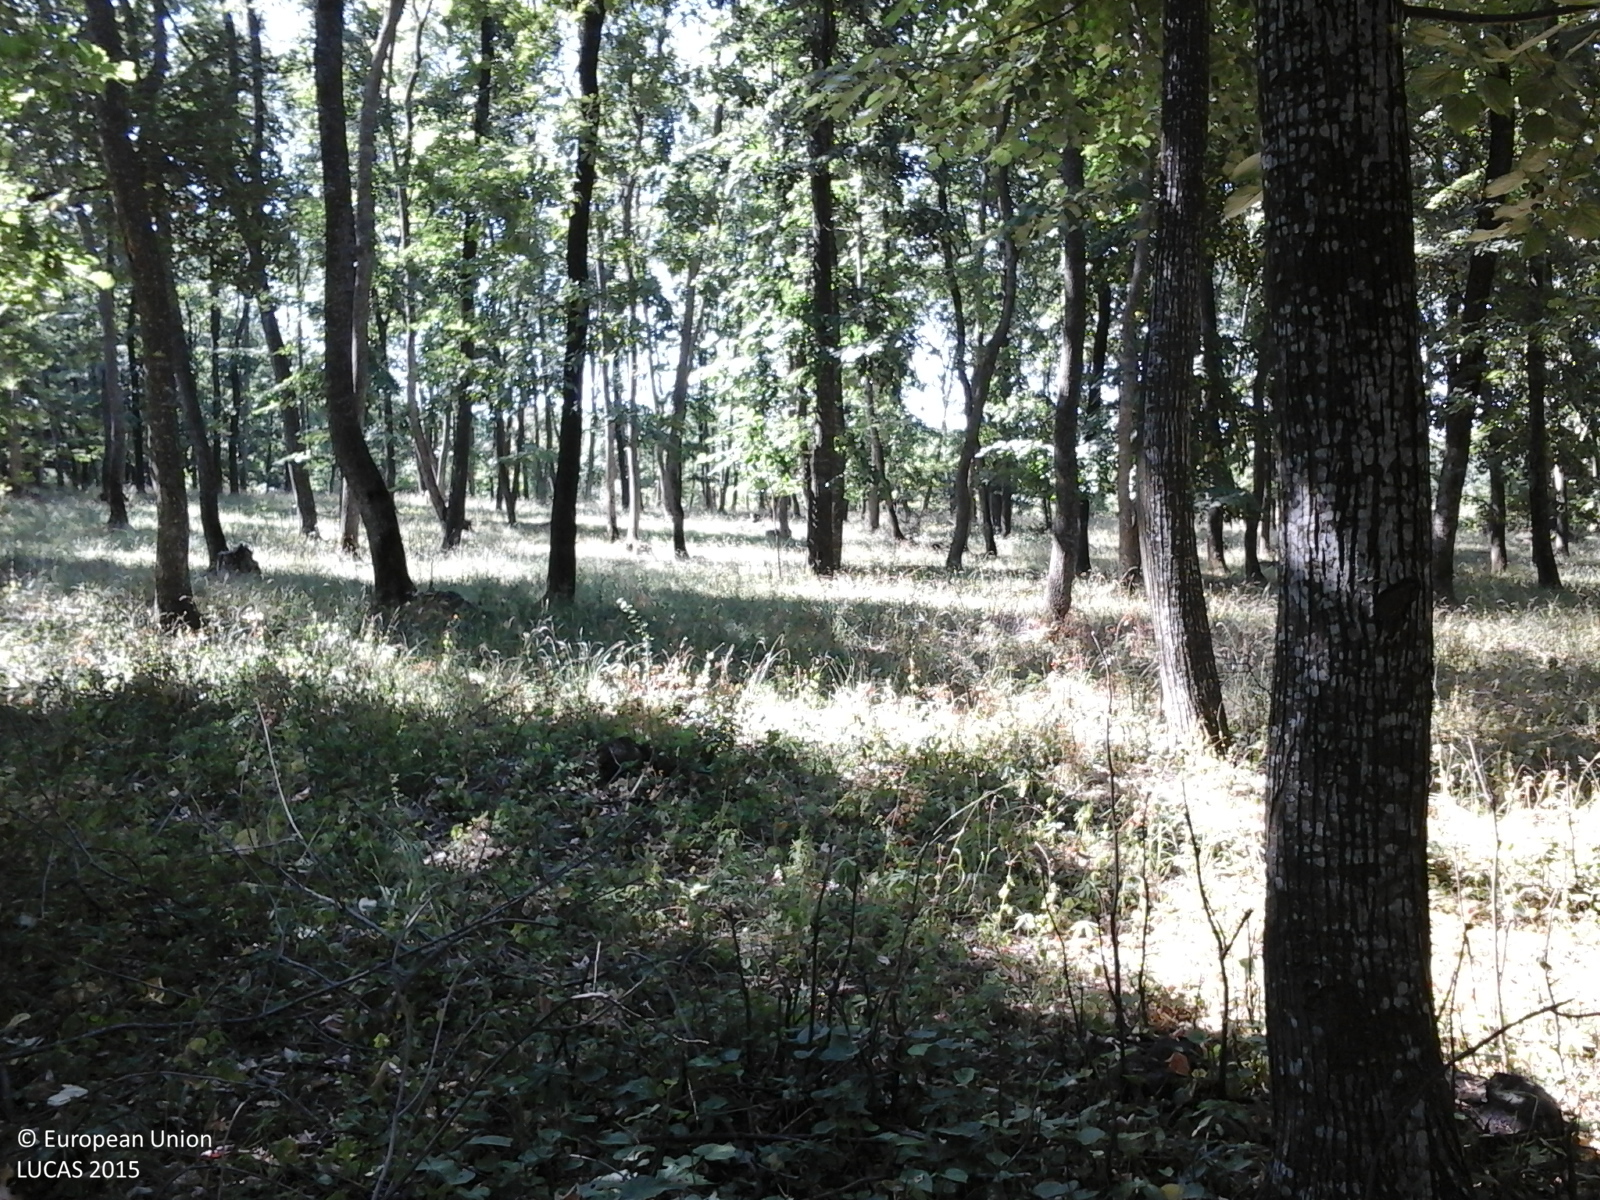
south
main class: Woodland
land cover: Broadleaved woodland
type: mesophytic deciduous forest
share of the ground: > 75 %
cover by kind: broadleaved forest trees 100 %
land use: Forestry
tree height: > 5 m
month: July
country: RO
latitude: 45.9999
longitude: 27.7128
